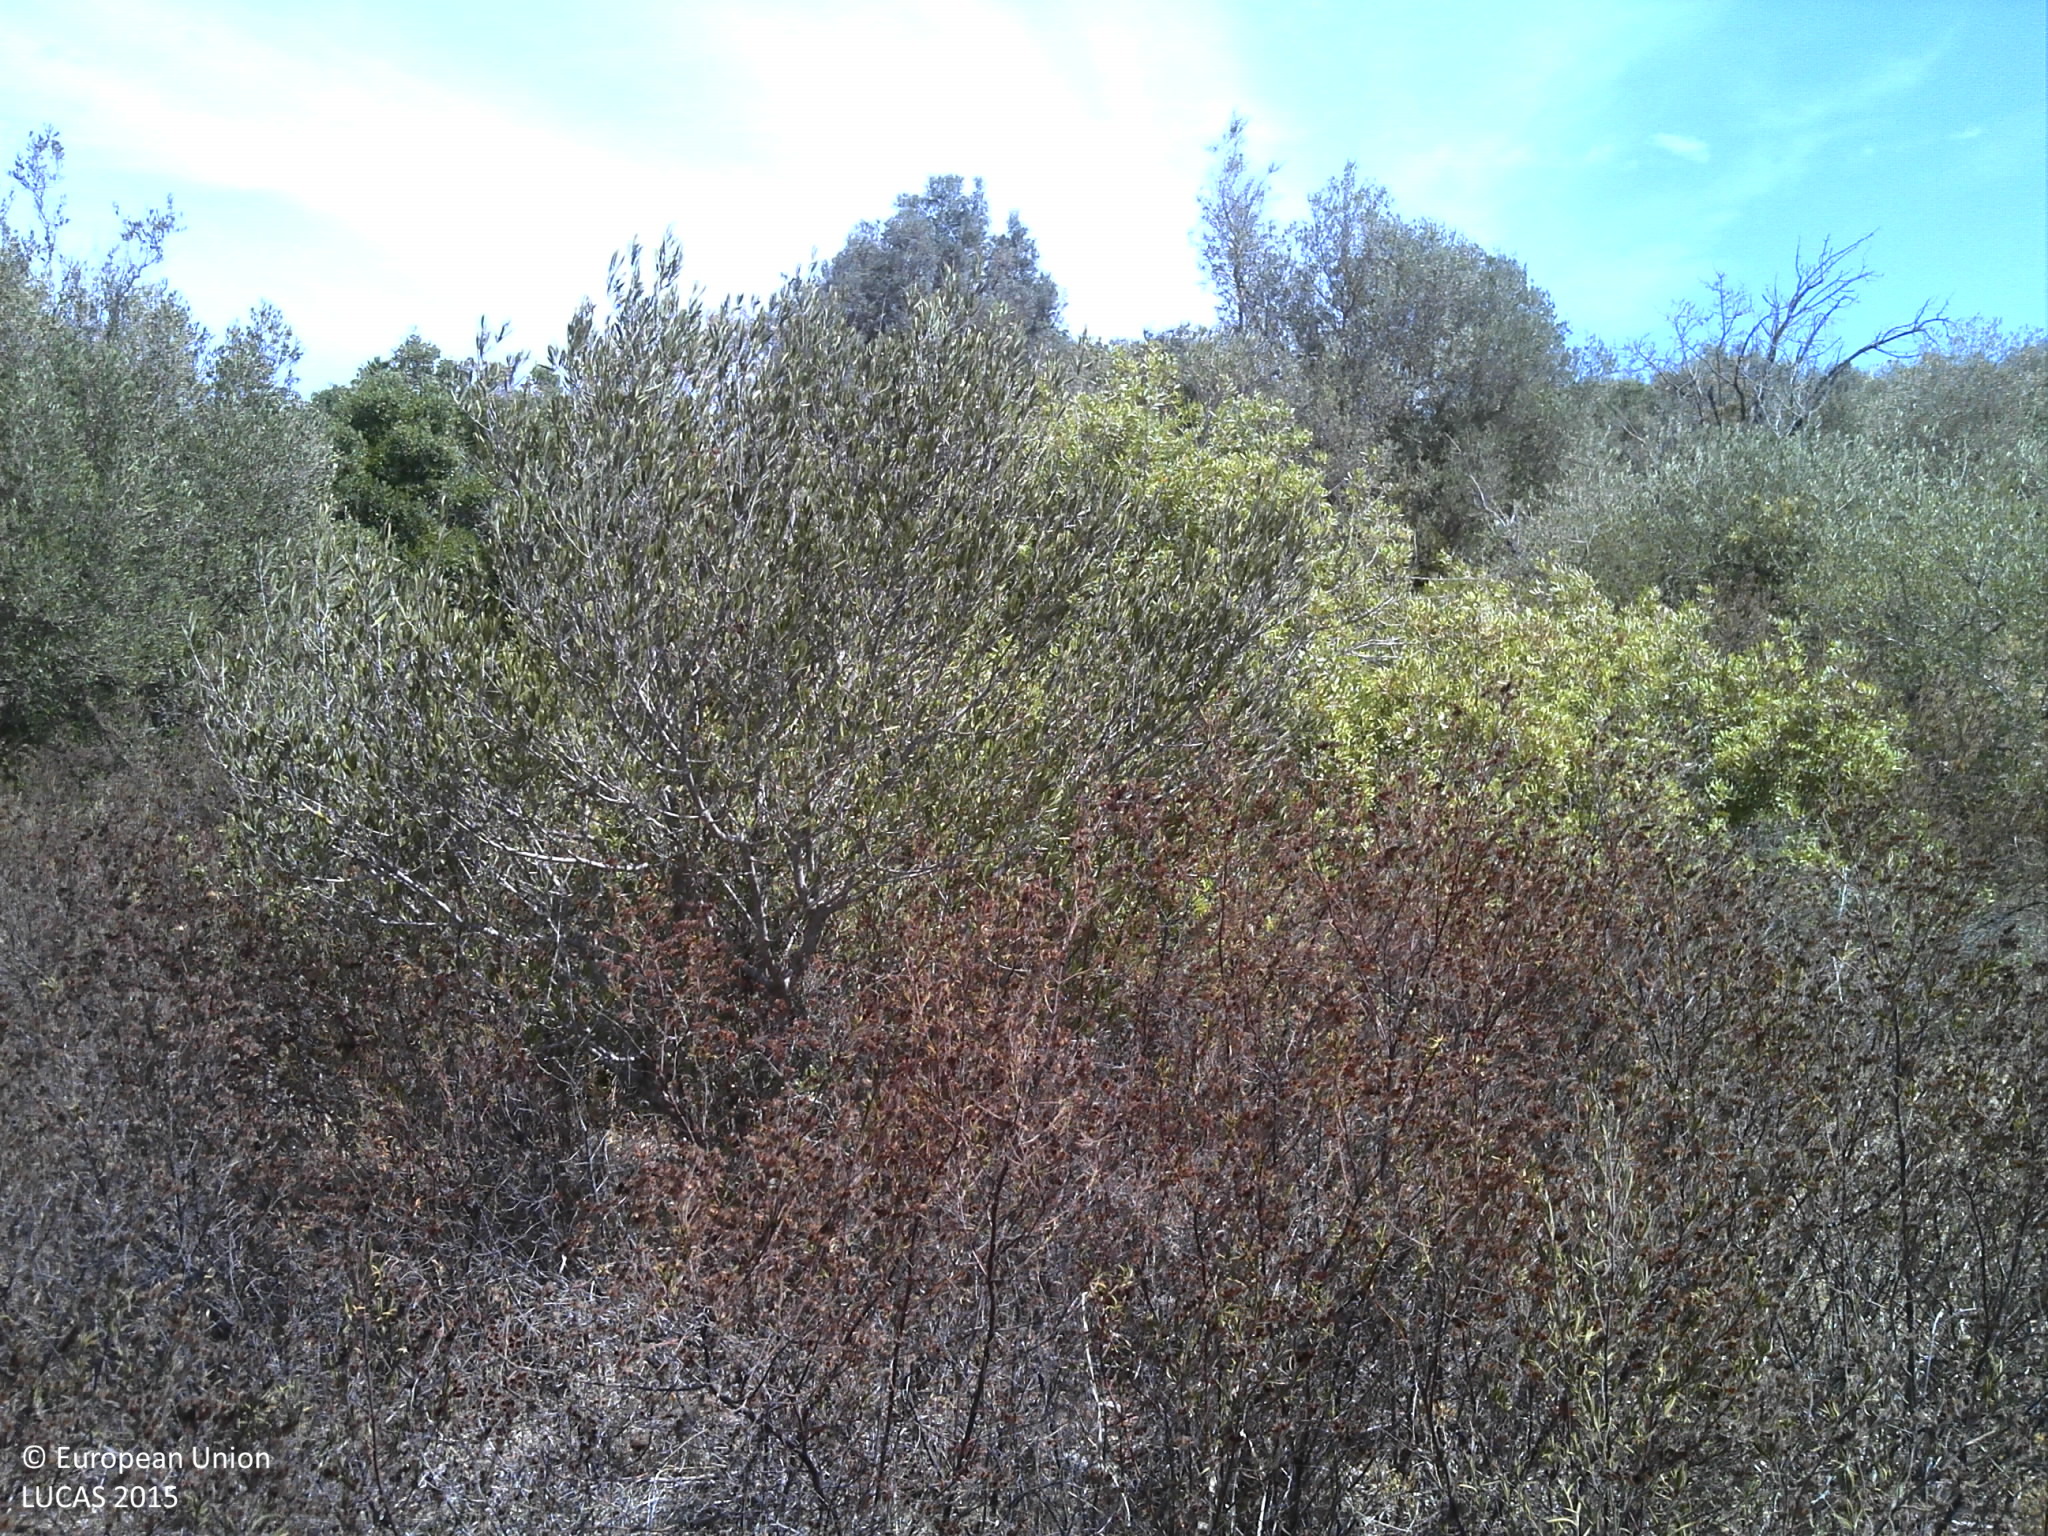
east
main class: Cropland
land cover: Olive groves
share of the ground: 25 - 50 %
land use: Abandoned areas
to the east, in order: Olive groves; Dry stone walls; Olive groves; Dry stone walls; Shrubland without tree cover; Olive groves; Nuts trees; Olive groves; Electric lines; Paved roads, cycling and walking lanes; Dry stone walls; Pine dominated mixed woodland; Other structural elements; Grassland without tree/shrub cover; Olive groves
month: September
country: PT
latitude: 37.1699
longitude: -8.6220
